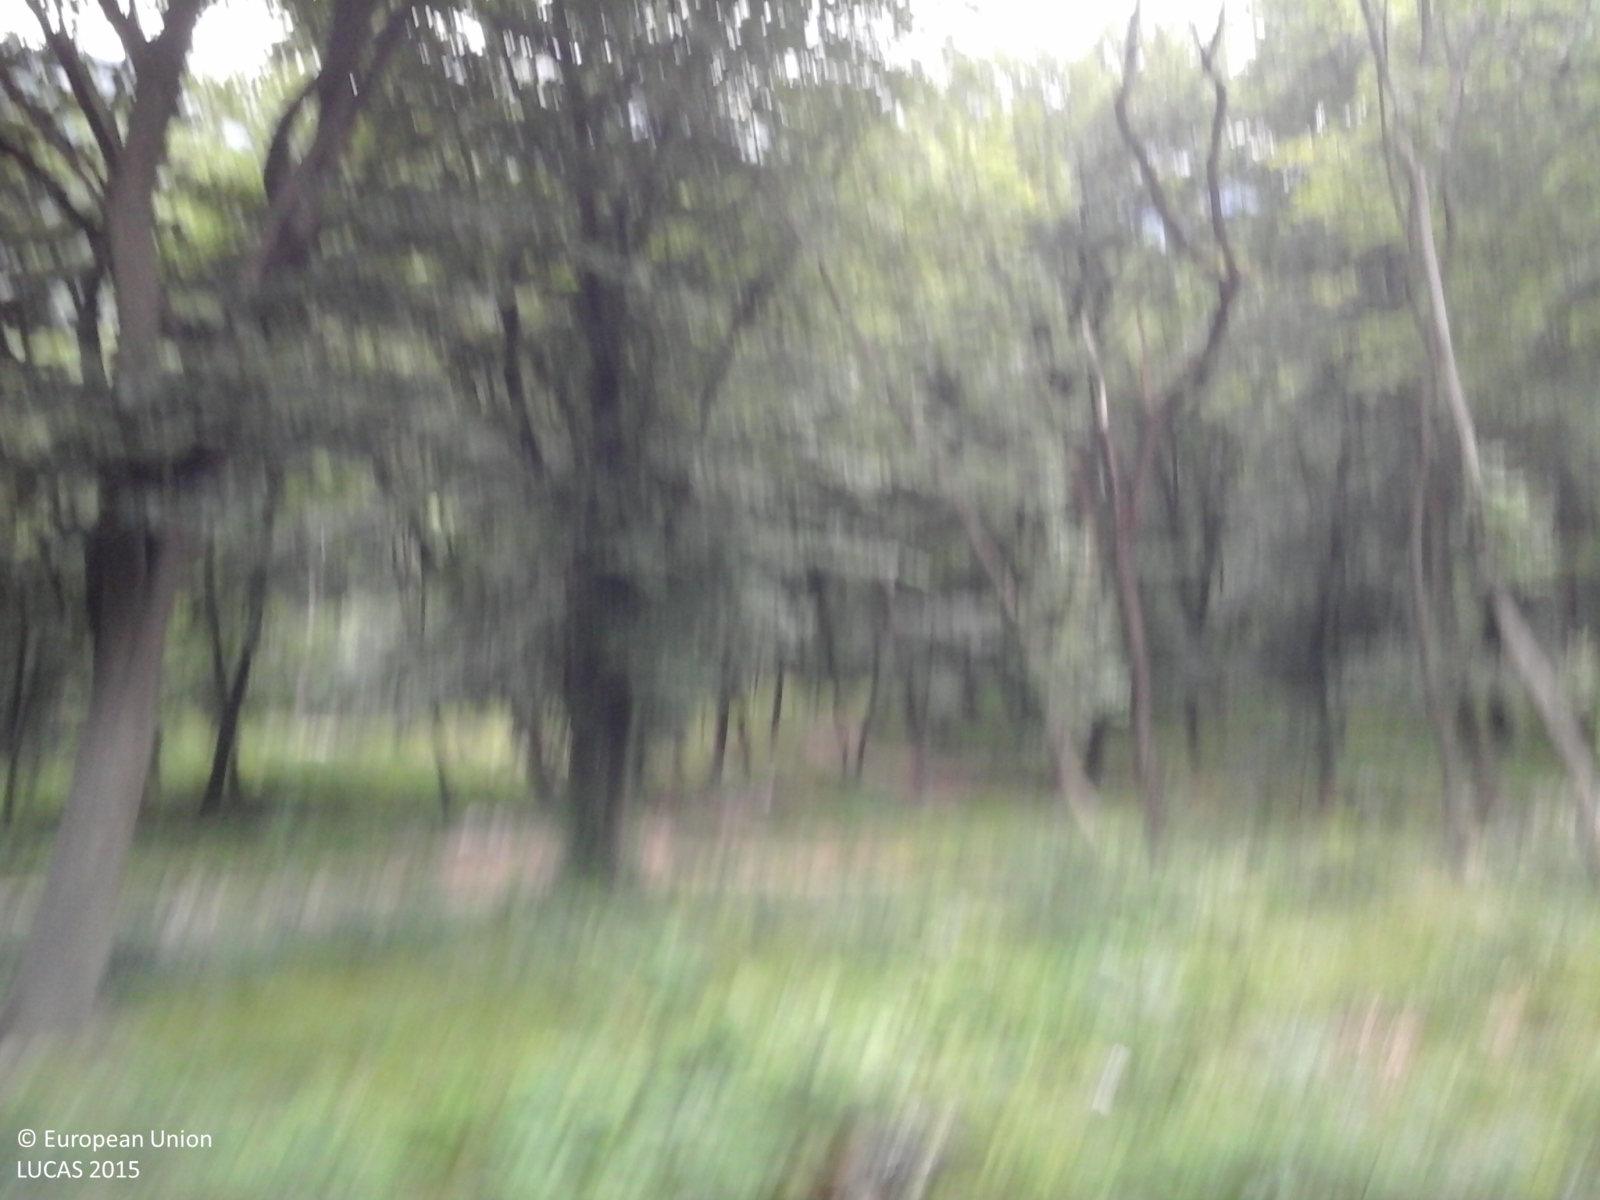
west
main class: Woodland
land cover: Broadleaved woodland
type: mountainous beech forest
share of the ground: > 75 %
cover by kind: broadleaved forest trees 90 %, herbaceous plants 10 %
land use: Forestry
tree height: > 5 m
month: May
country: IT
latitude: 45.6985
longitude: 10.9360
